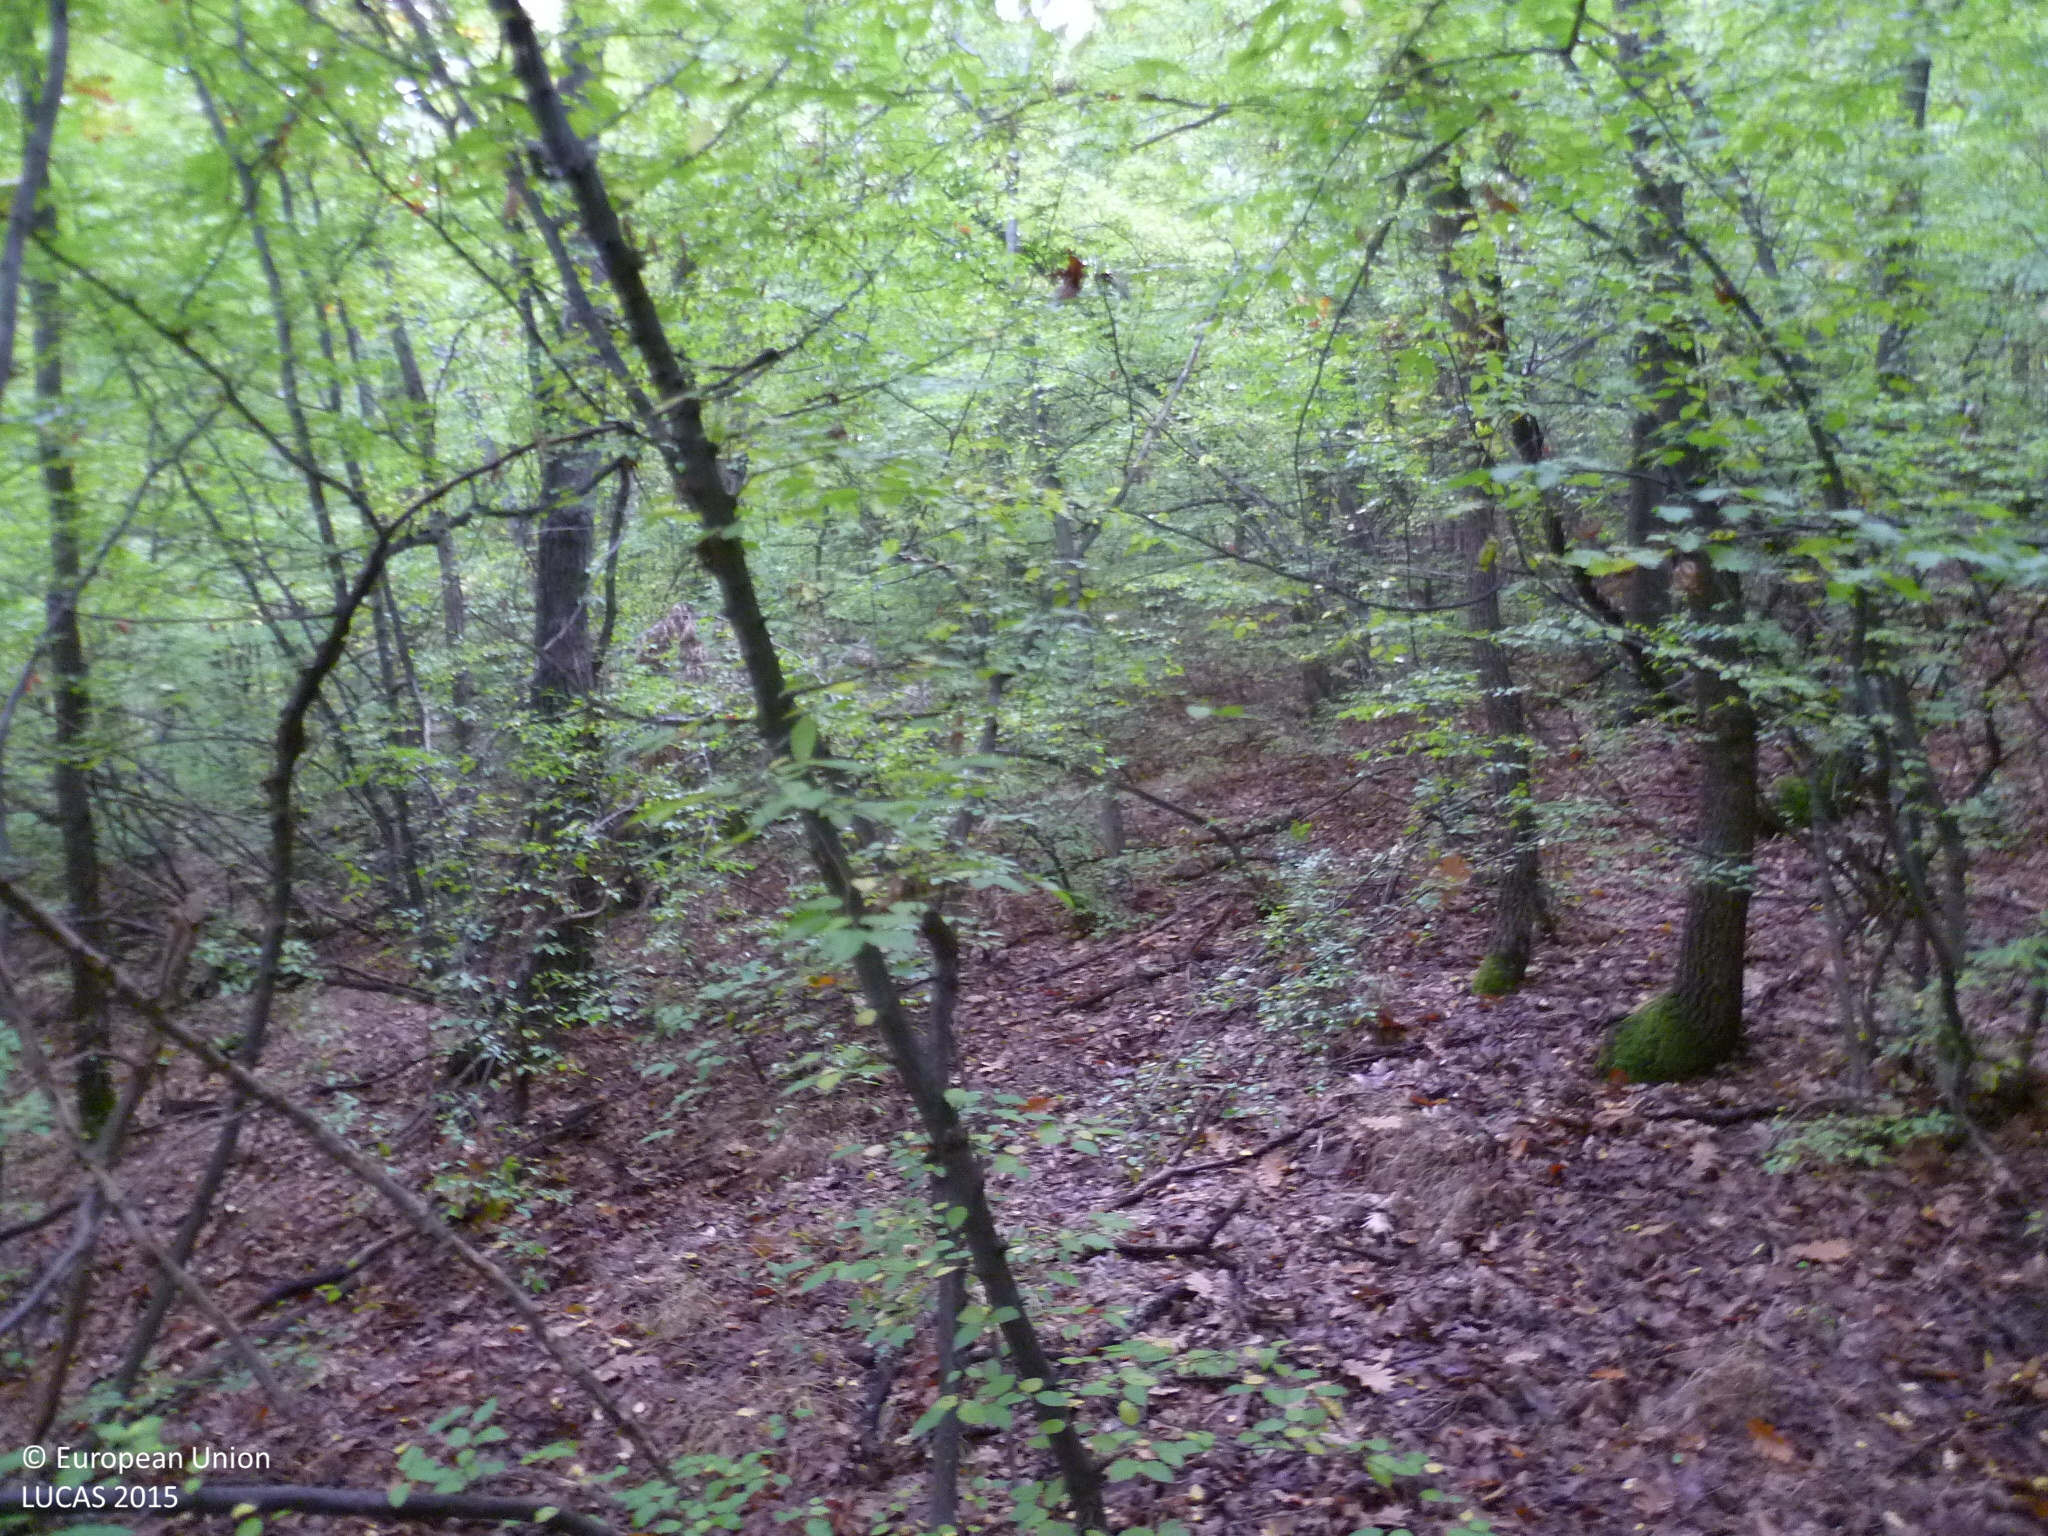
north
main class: Woodland
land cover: Broadleaved woodland
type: mesophytic deciduous forest
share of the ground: > 75 %
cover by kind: broadleaved forest trees 80 %, unconsolidated bare surface 15 %, lichens and mosses 5 %
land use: Forestry
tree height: > 5 m
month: October
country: BG
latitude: 42.3603
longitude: 23.8189
